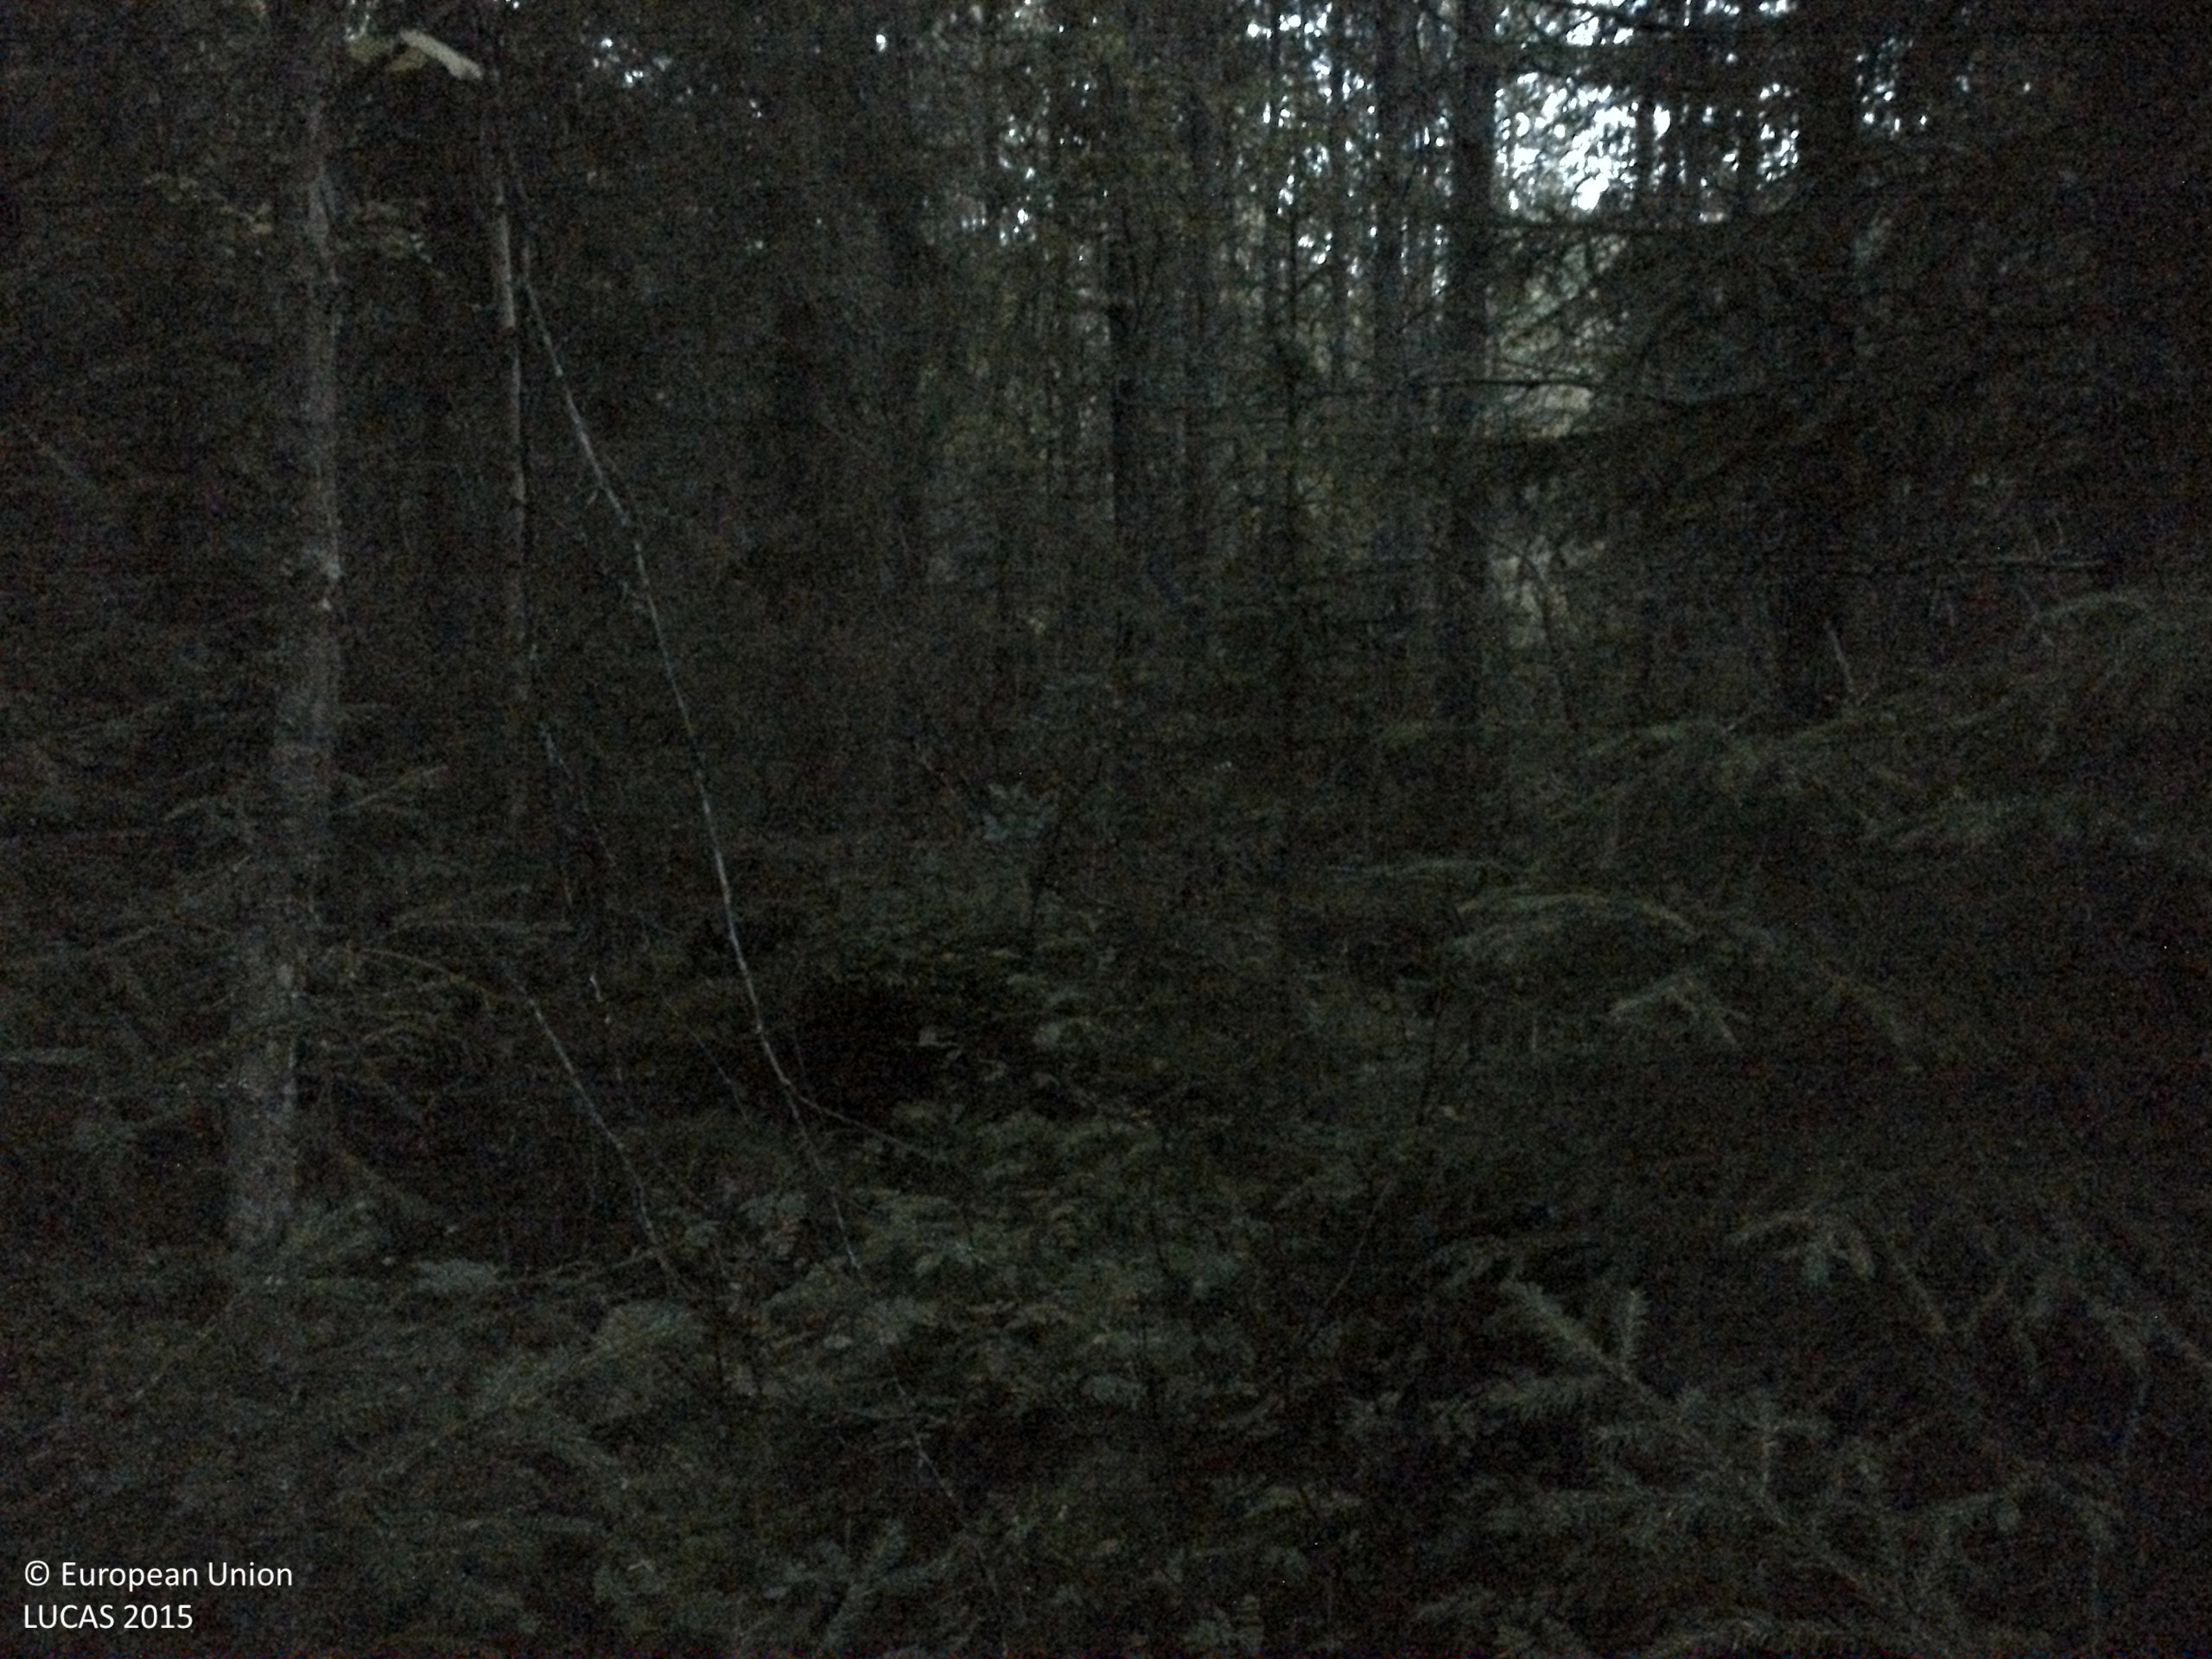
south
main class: Woodland
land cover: Pine dominated coniferous woodland
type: exotic forest
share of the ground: > 75 %
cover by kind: coniferous forest trees 70 %, broadleaved forest trees 10 %, shrubs 10 %, lichens and mosses 10 %
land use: Forestry
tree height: > 5 m
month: September
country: SE
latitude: 63.9149
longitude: 16.6368
